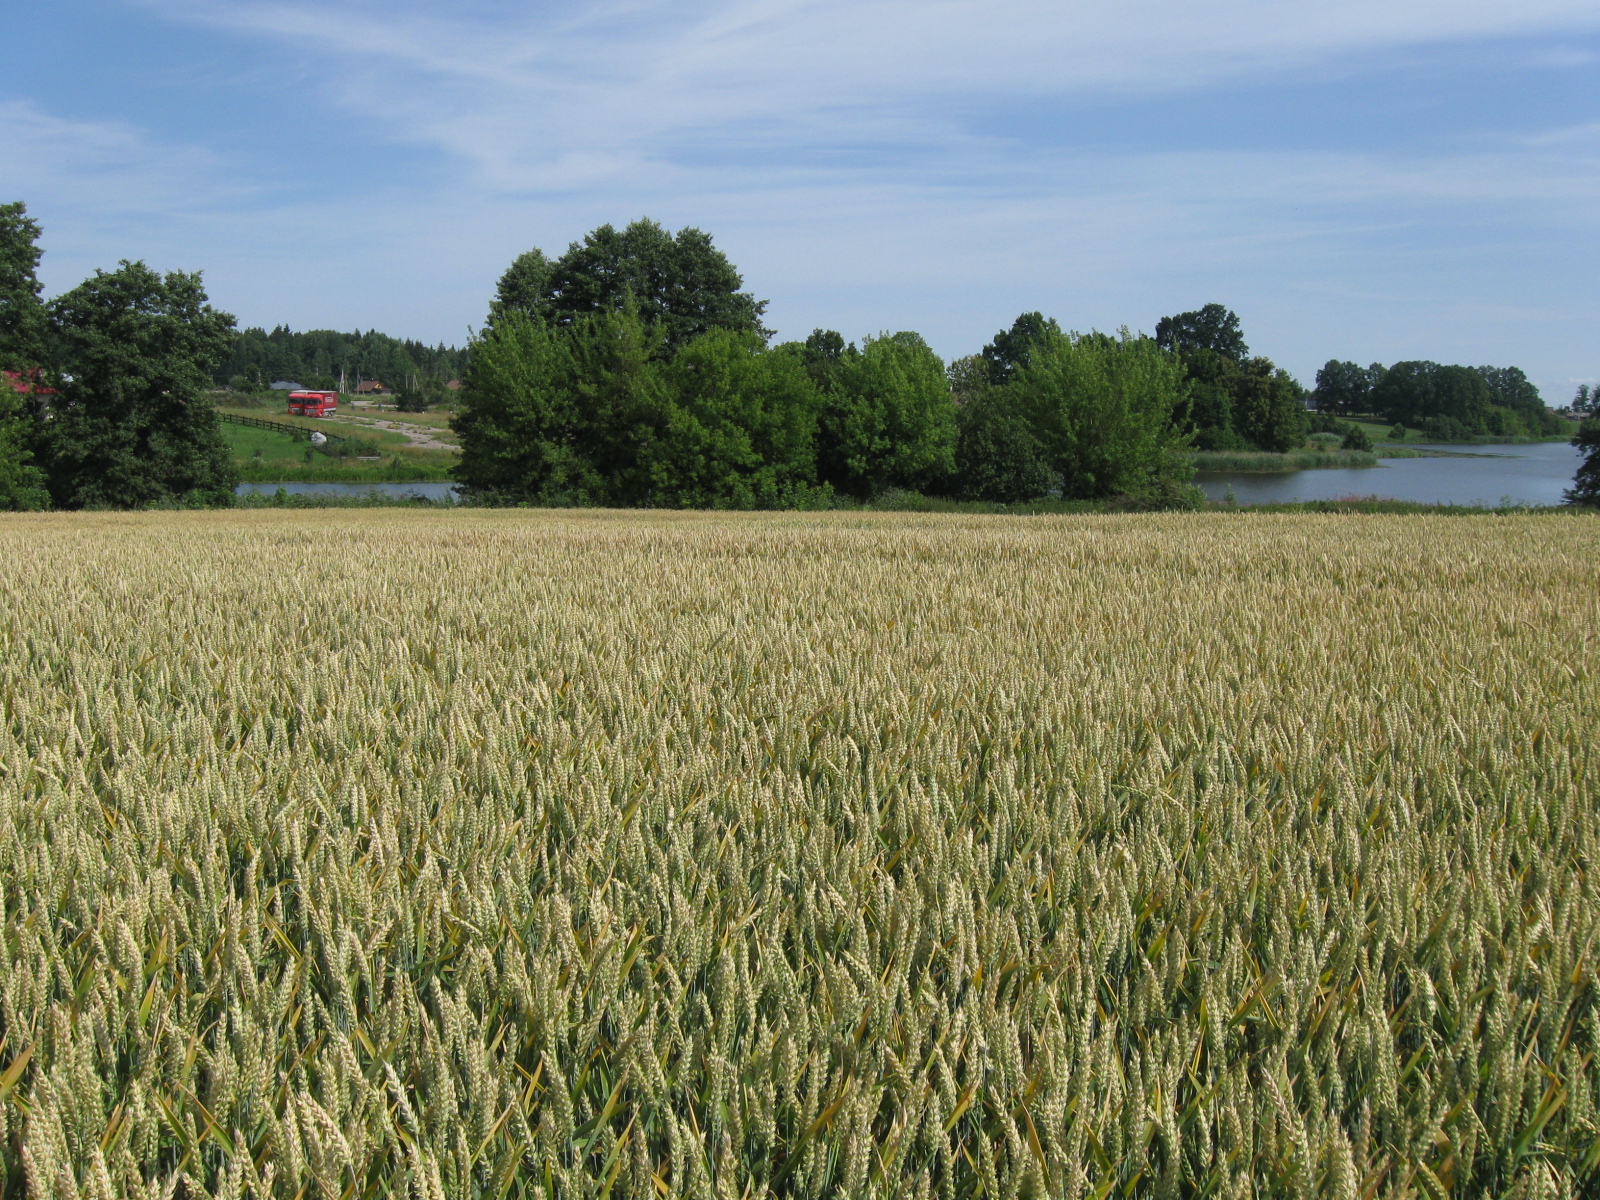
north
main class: Cropland
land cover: Common wheat
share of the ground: > 75 %
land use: Agriculture (excluding fallow land and kitchen gardens)
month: July
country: LT
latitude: 54.7499
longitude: 23.9013
